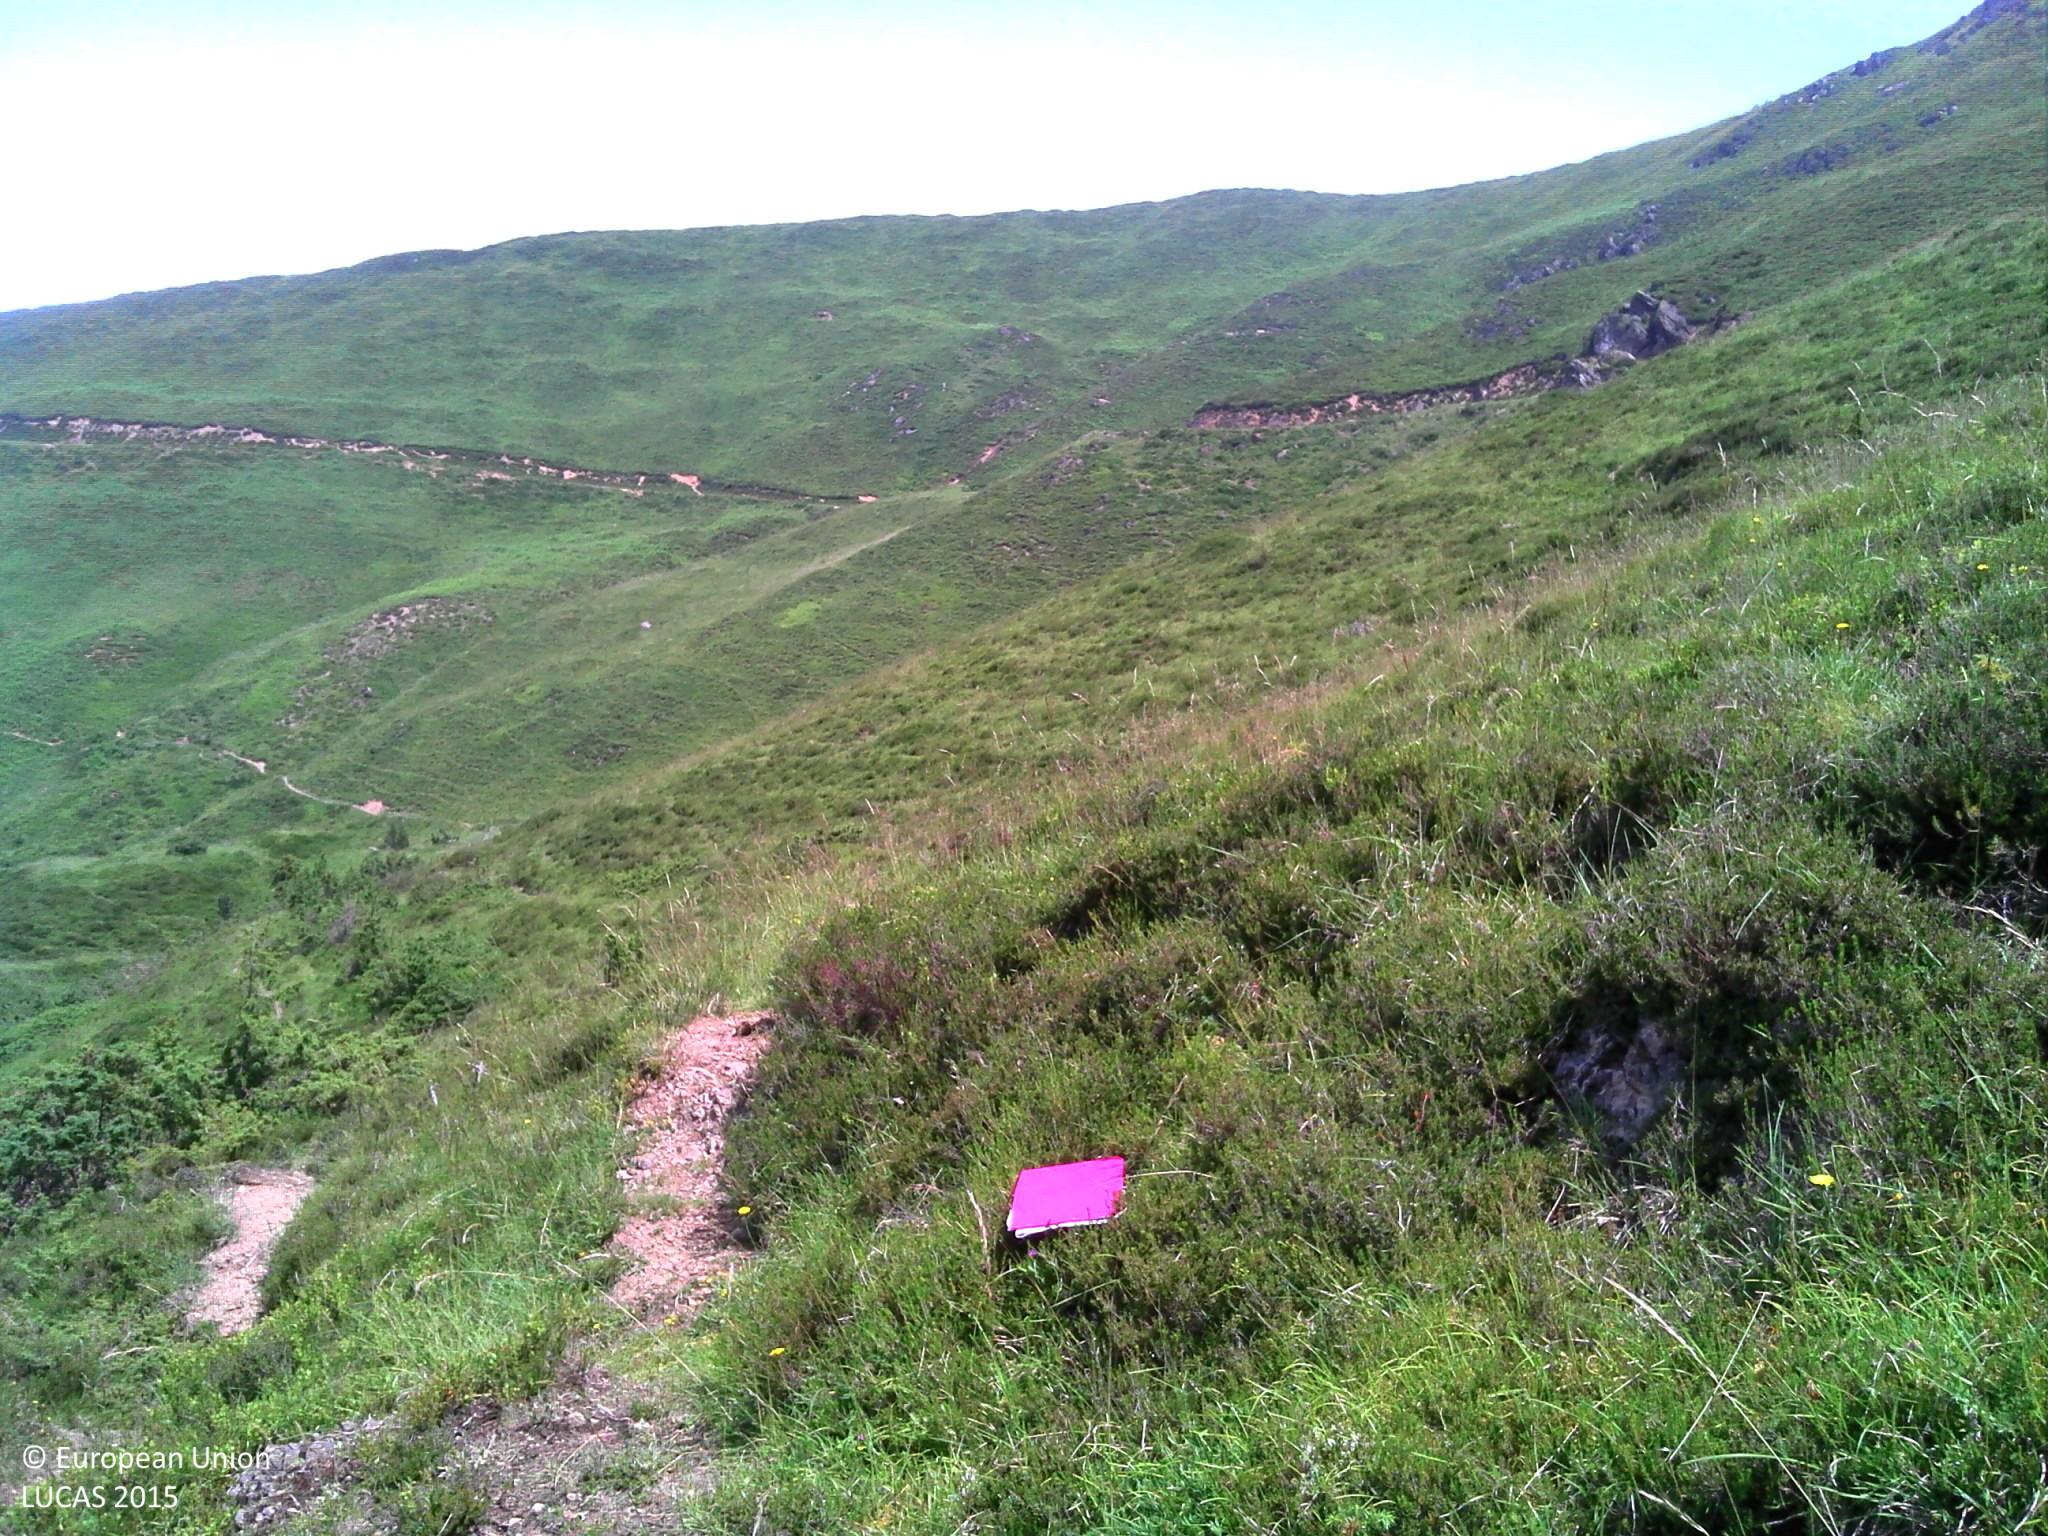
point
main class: Shrubland
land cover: Shrubland without tree cover
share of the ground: > 75 %
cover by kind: shrubs 60 %, herbaceous plants 40 %
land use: Agriculture (excluding fallow land and kitchen gardens)
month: July
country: FR
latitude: 42.9677
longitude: -0.2655
